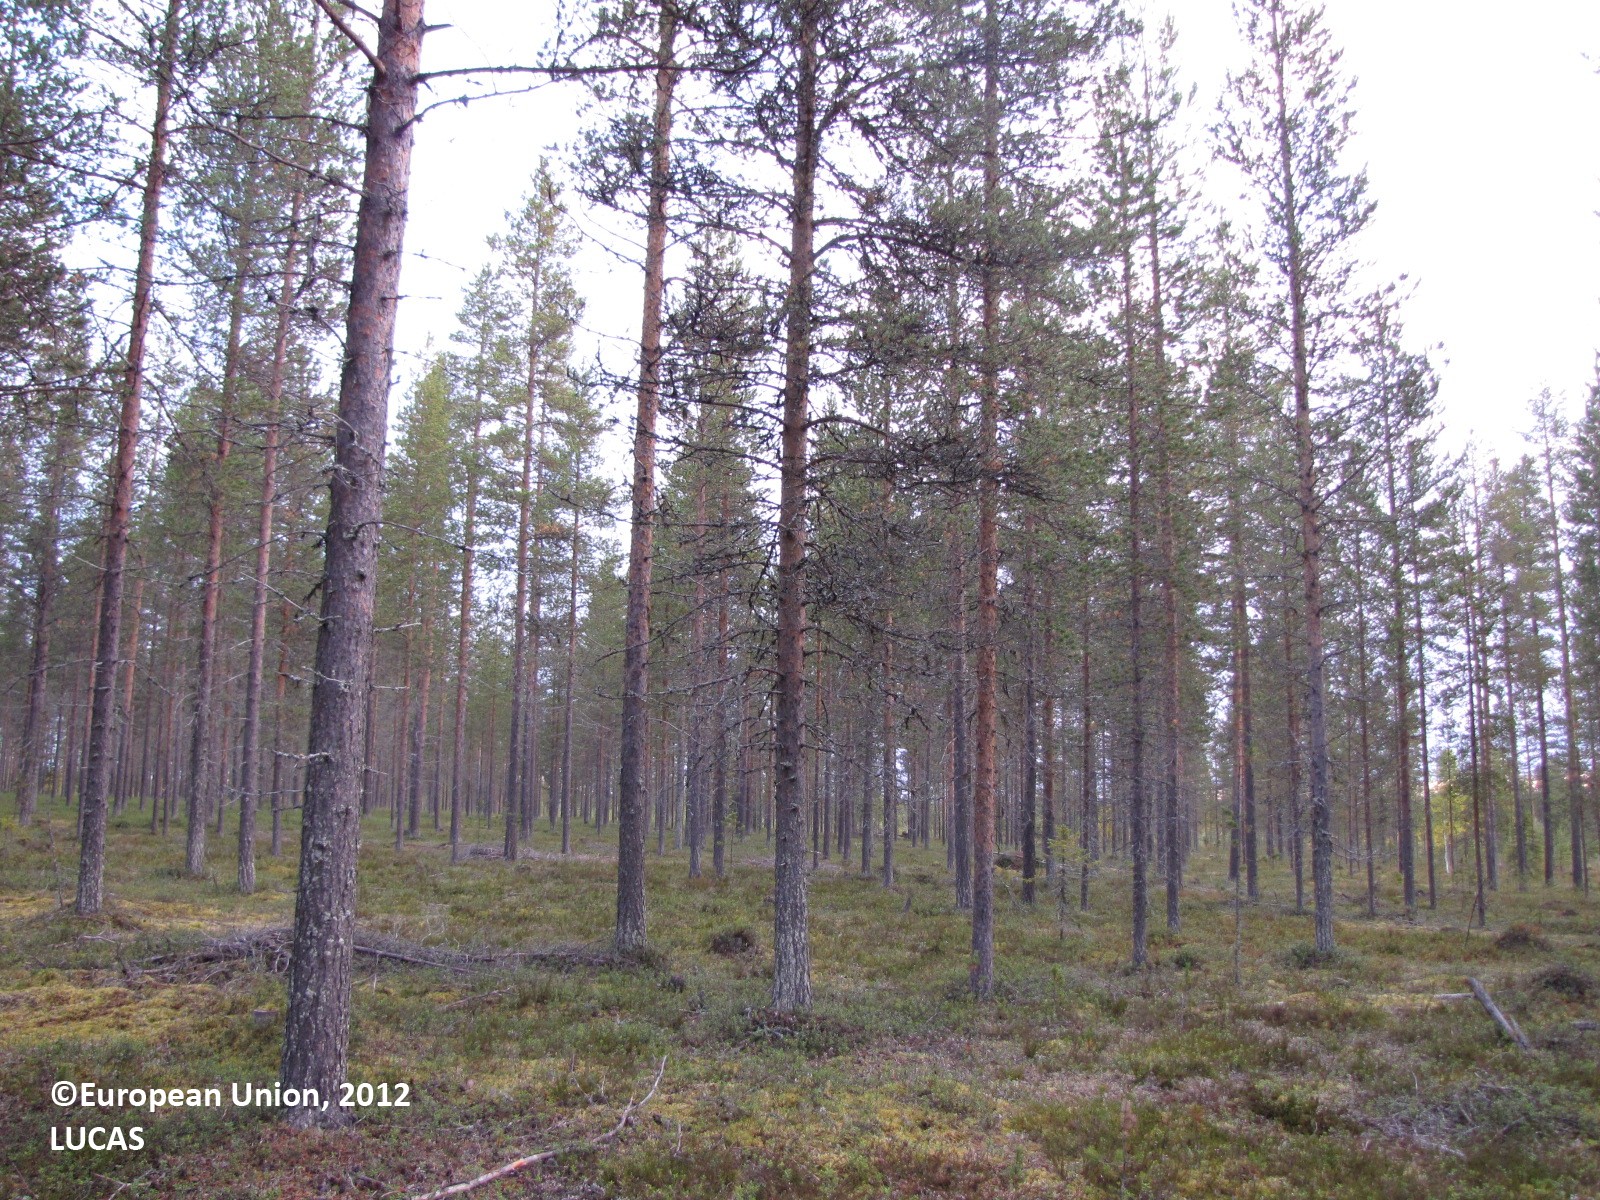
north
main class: Woodland
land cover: Pine dominated coniferous woodland
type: boreal forest
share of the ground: 50 - 75 %
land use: Forestry
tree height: > 5 m
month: September
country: FI
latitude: 67.3139
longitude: 24.8870
